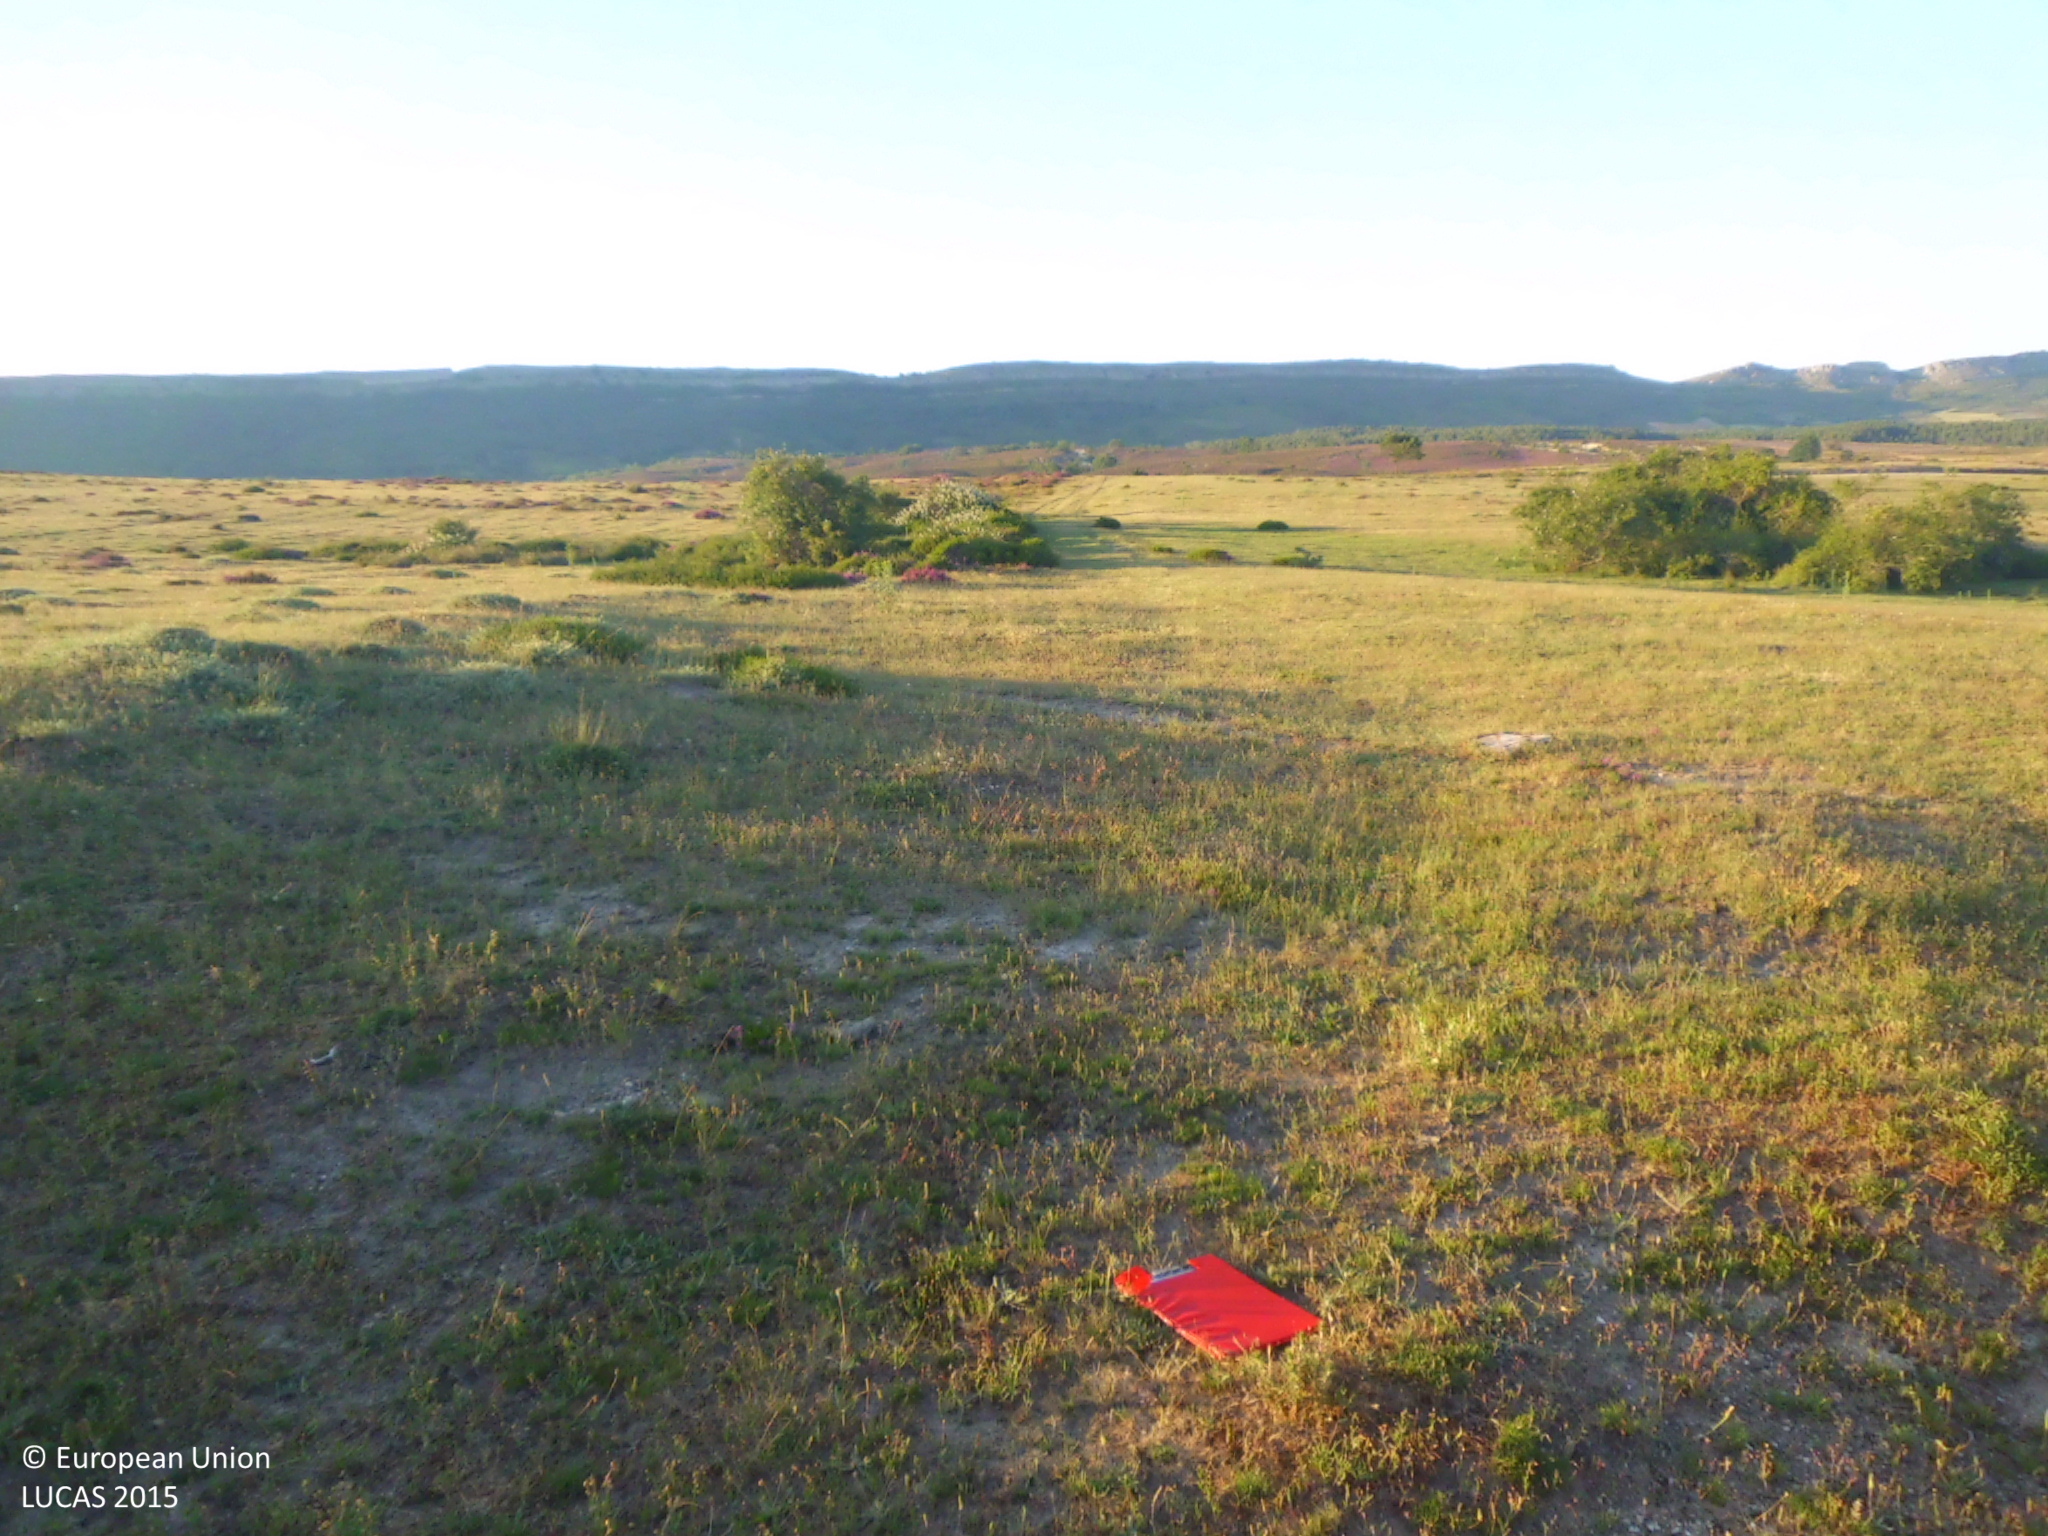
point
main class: Grassland
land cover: Grassland without tree/shrub cover
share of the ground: > 75 %
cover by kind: herbaceous plants 85 %, consolidated bare surface 15 %
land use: Agriculture (excluding fallow land and kitchen gardens)
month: June
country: ES
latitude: 42.6127
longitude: -3.9771
